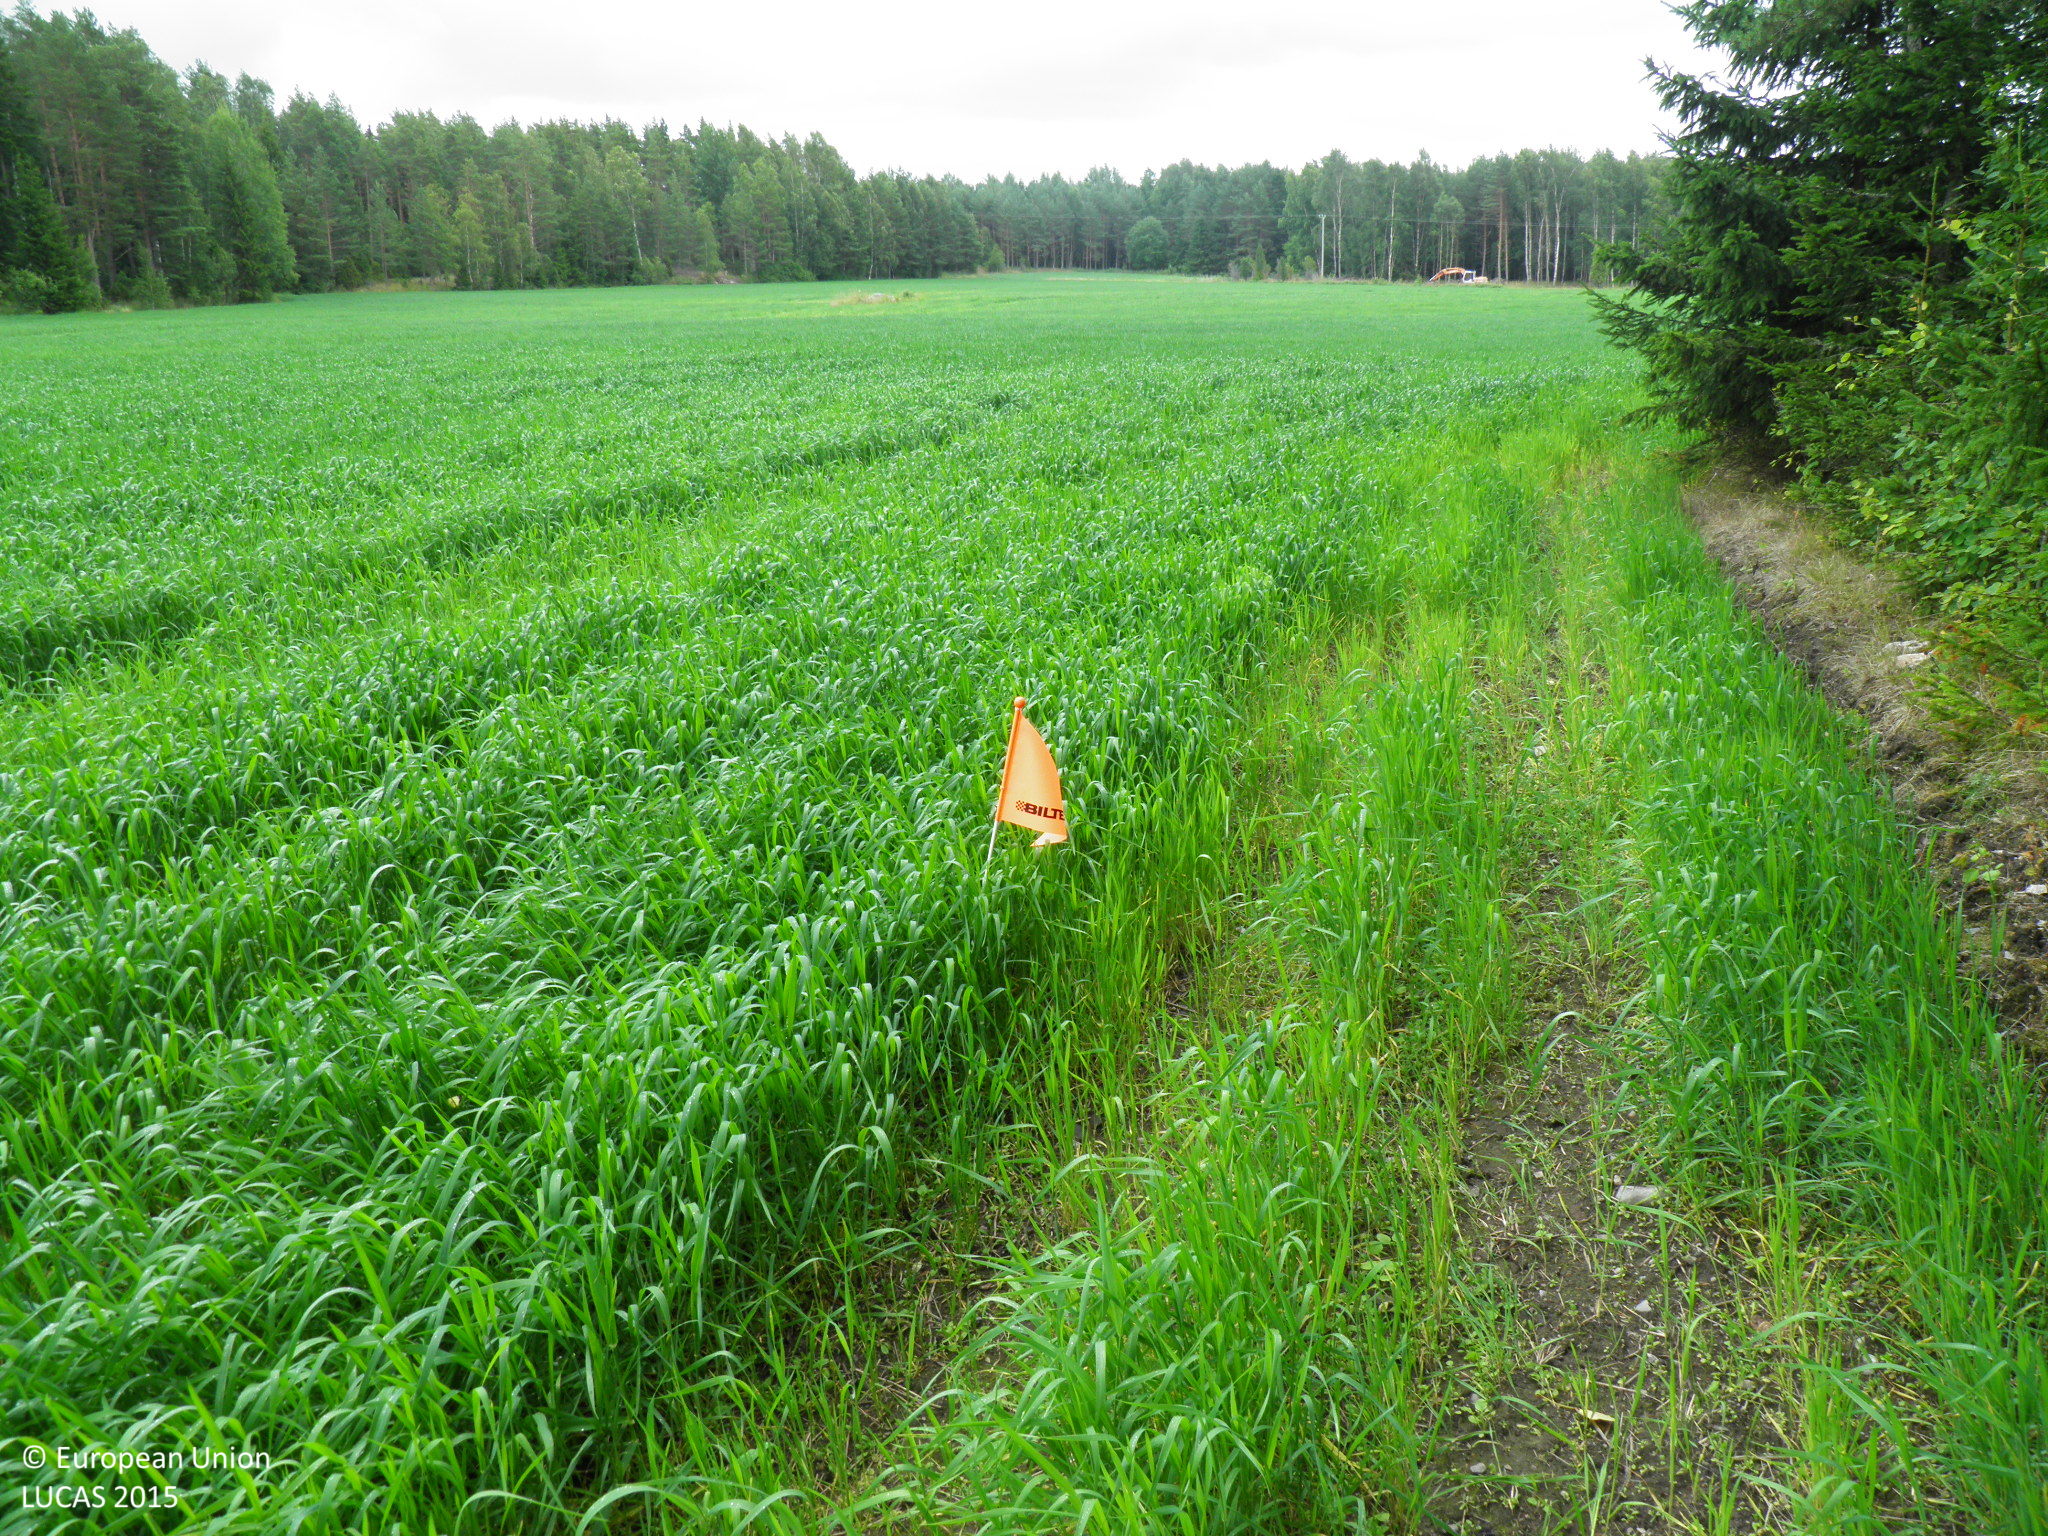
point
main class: Cropland
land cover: Common wheat
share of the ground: > 75 %
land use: Agriculture (excluding fallow land and kitchen gardens)
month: July
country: FI
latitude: 60.6571
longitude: 21.4894
